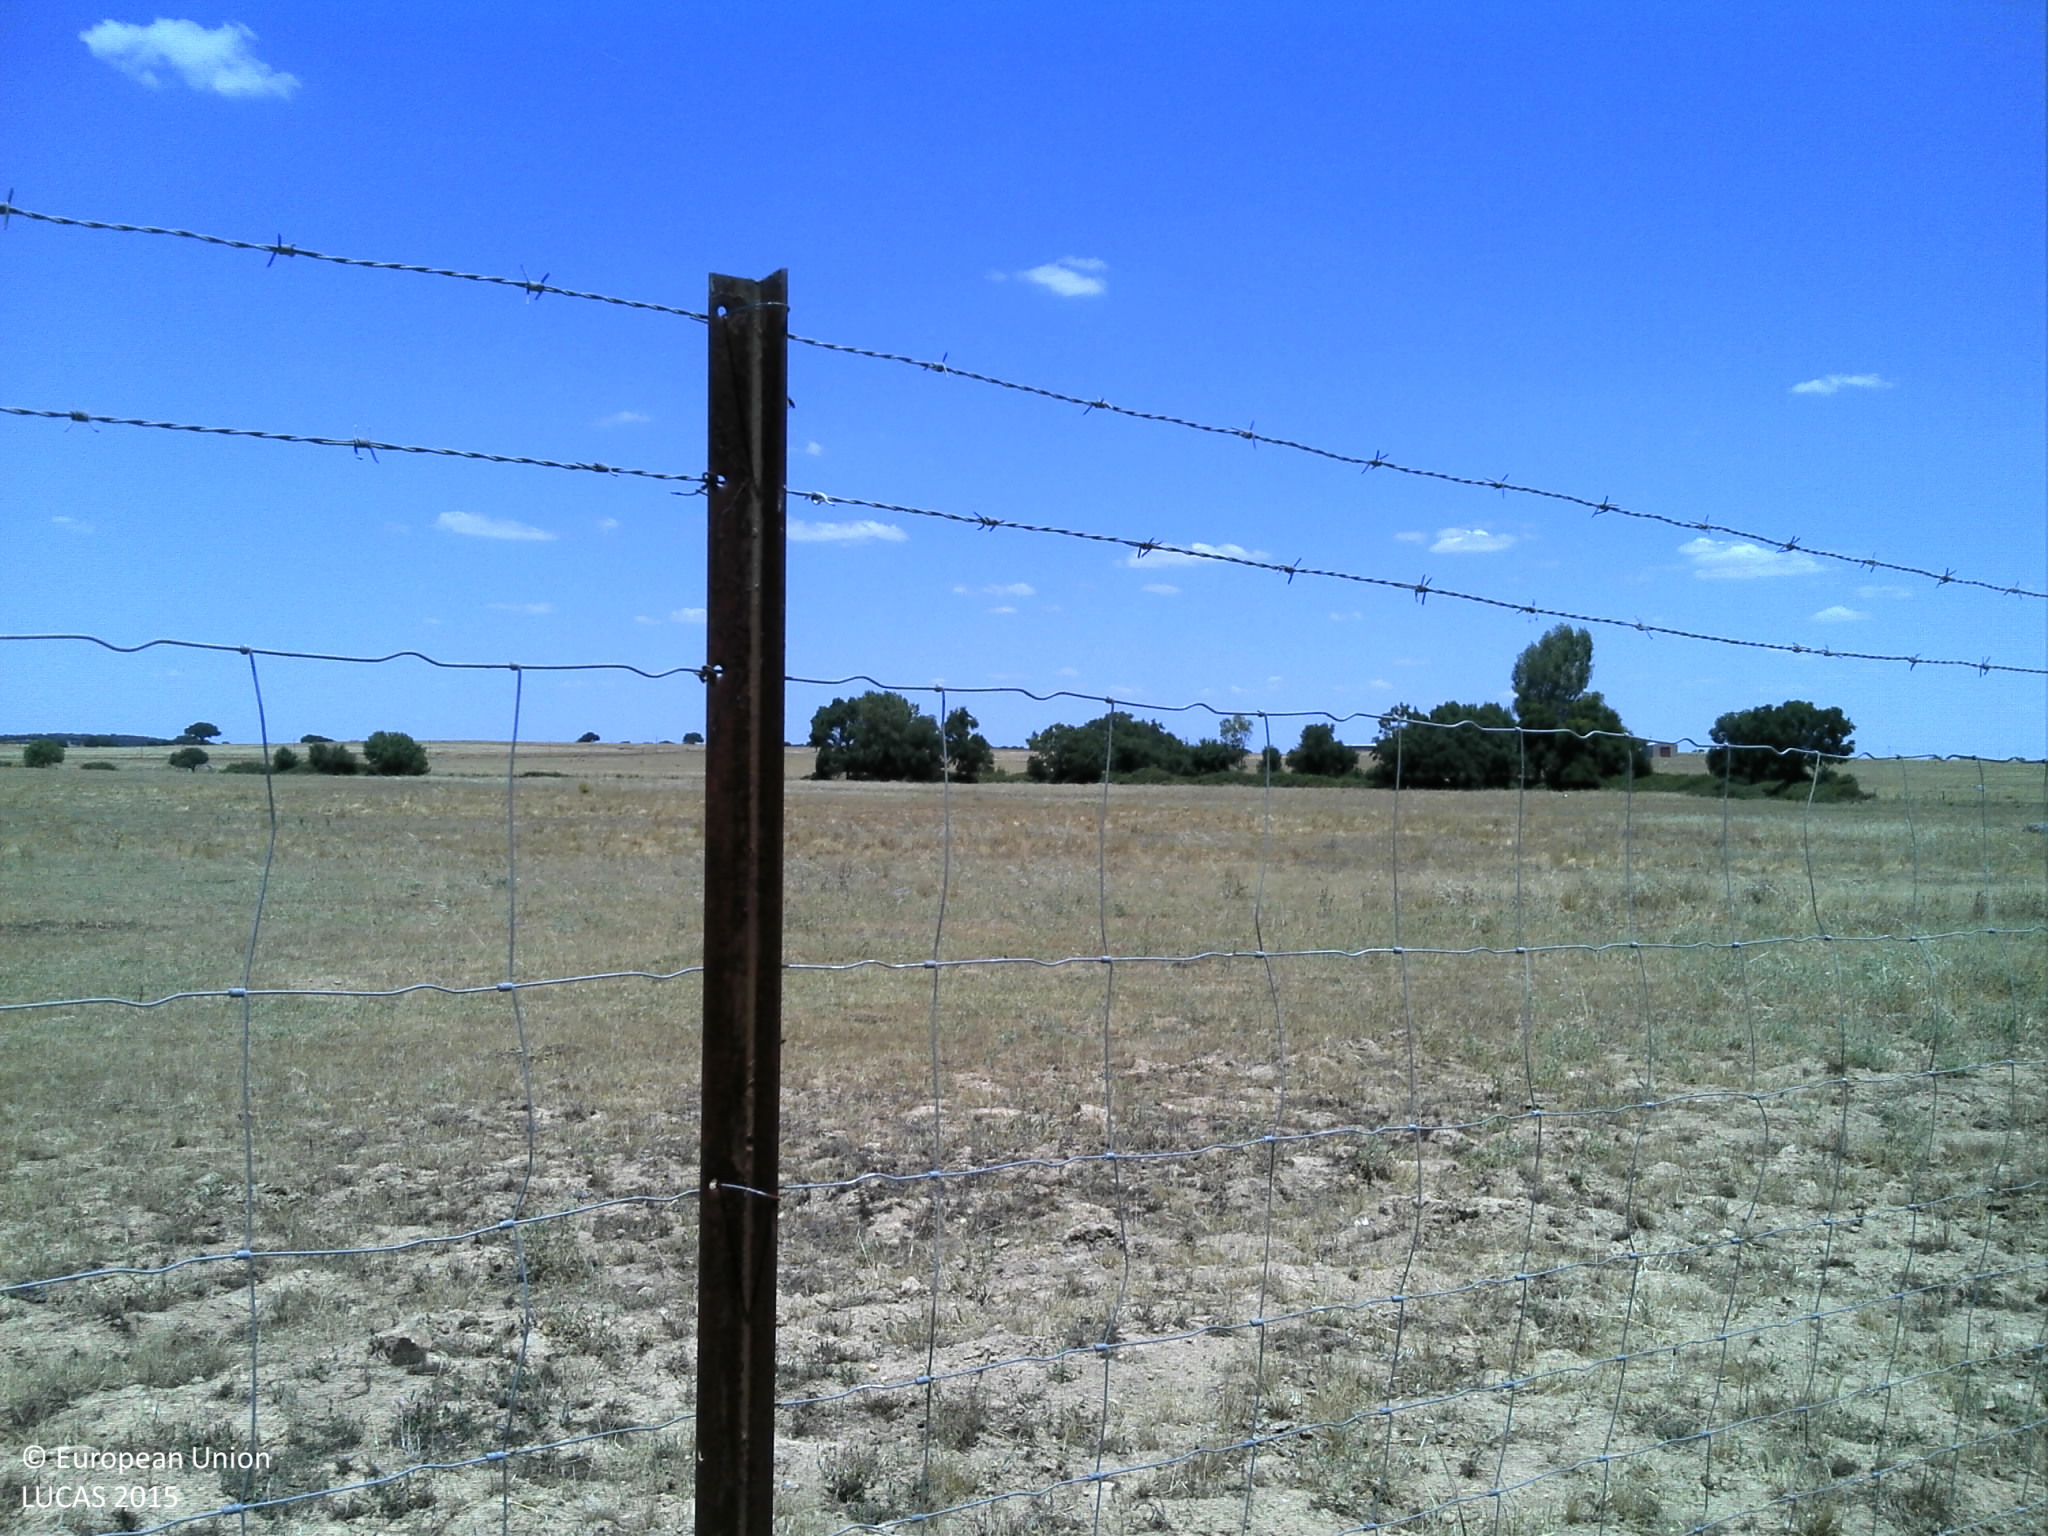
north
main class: Grassland
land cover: Grassland without tree/shrub cover
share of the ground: 10 - 25 %
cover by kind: unconsolidated bare surface 90 %, herbaceous plants 10 %
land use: Agriculture (excluding fallow land and kitchen gardens)
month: June
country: PT
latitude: 38.3665
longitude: -8.0892
